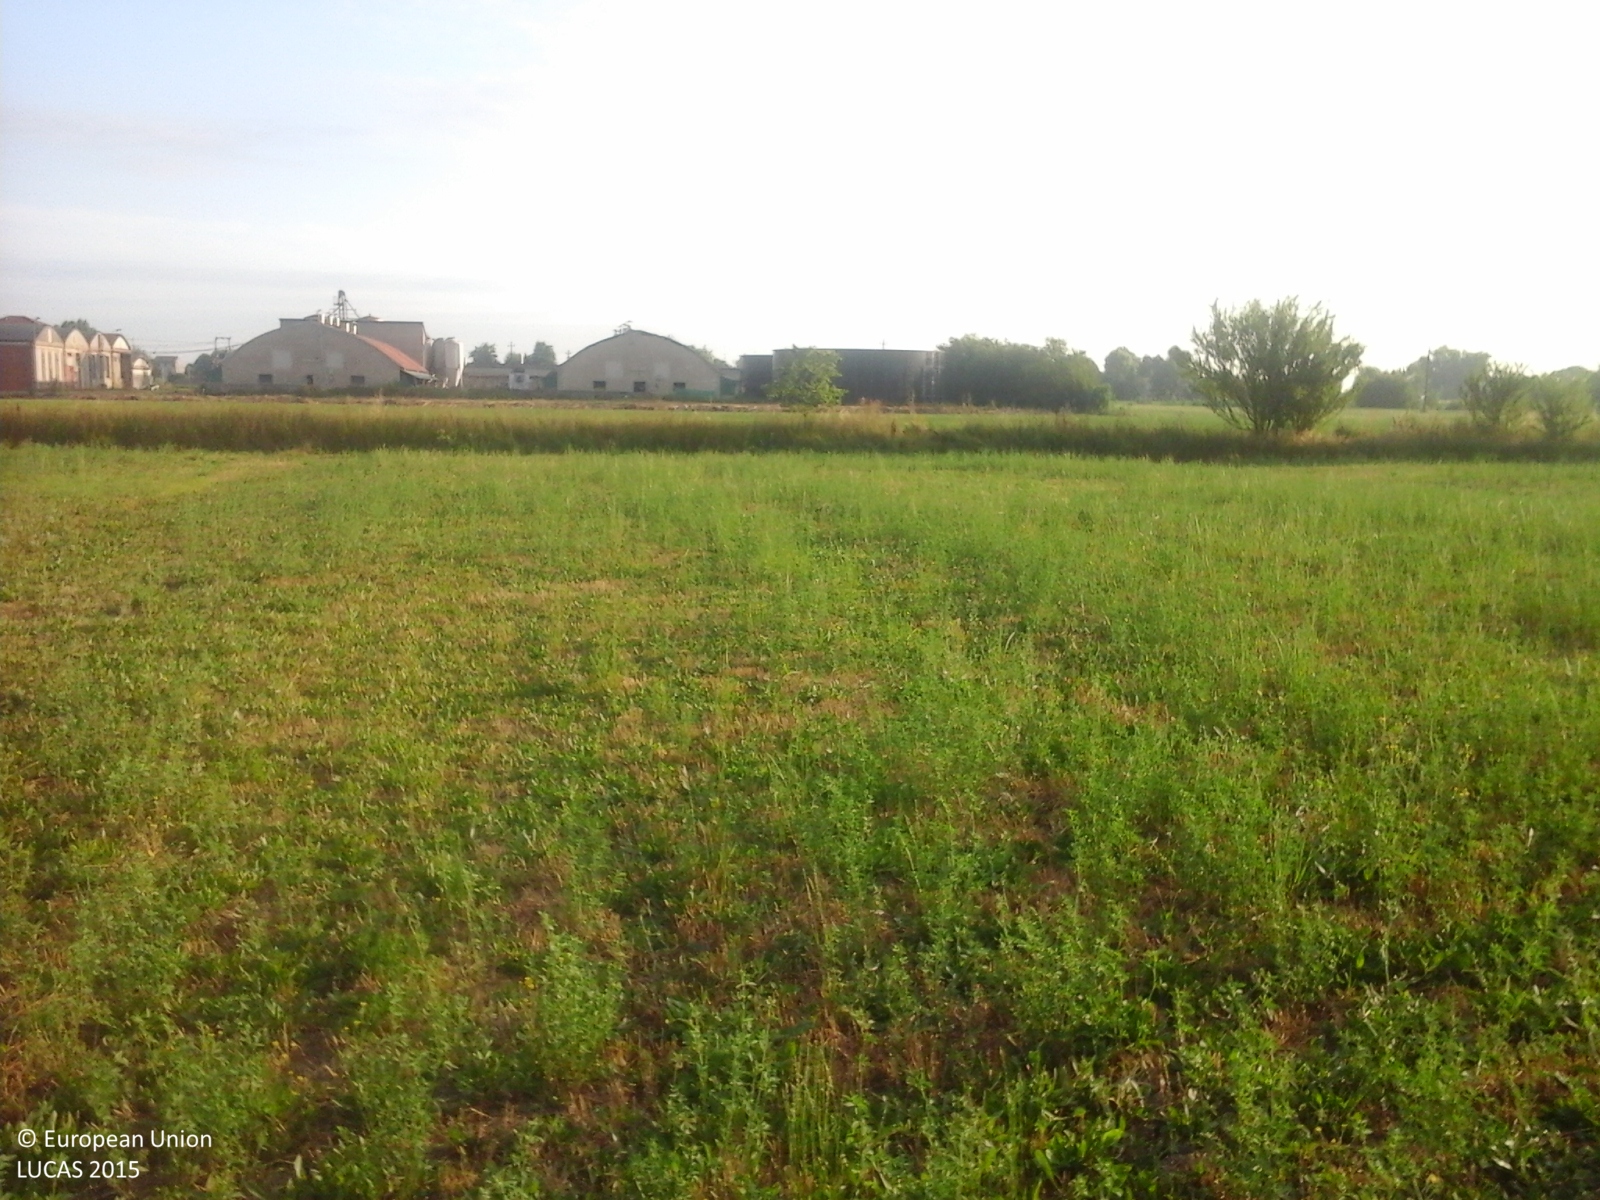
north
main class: Cropland
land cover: Lucerne
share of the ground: > 75 %
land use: Agriculture (excluding fallow land and kitchen gardens)
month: June
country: IT
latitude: 44.9406
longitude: 11.0245
